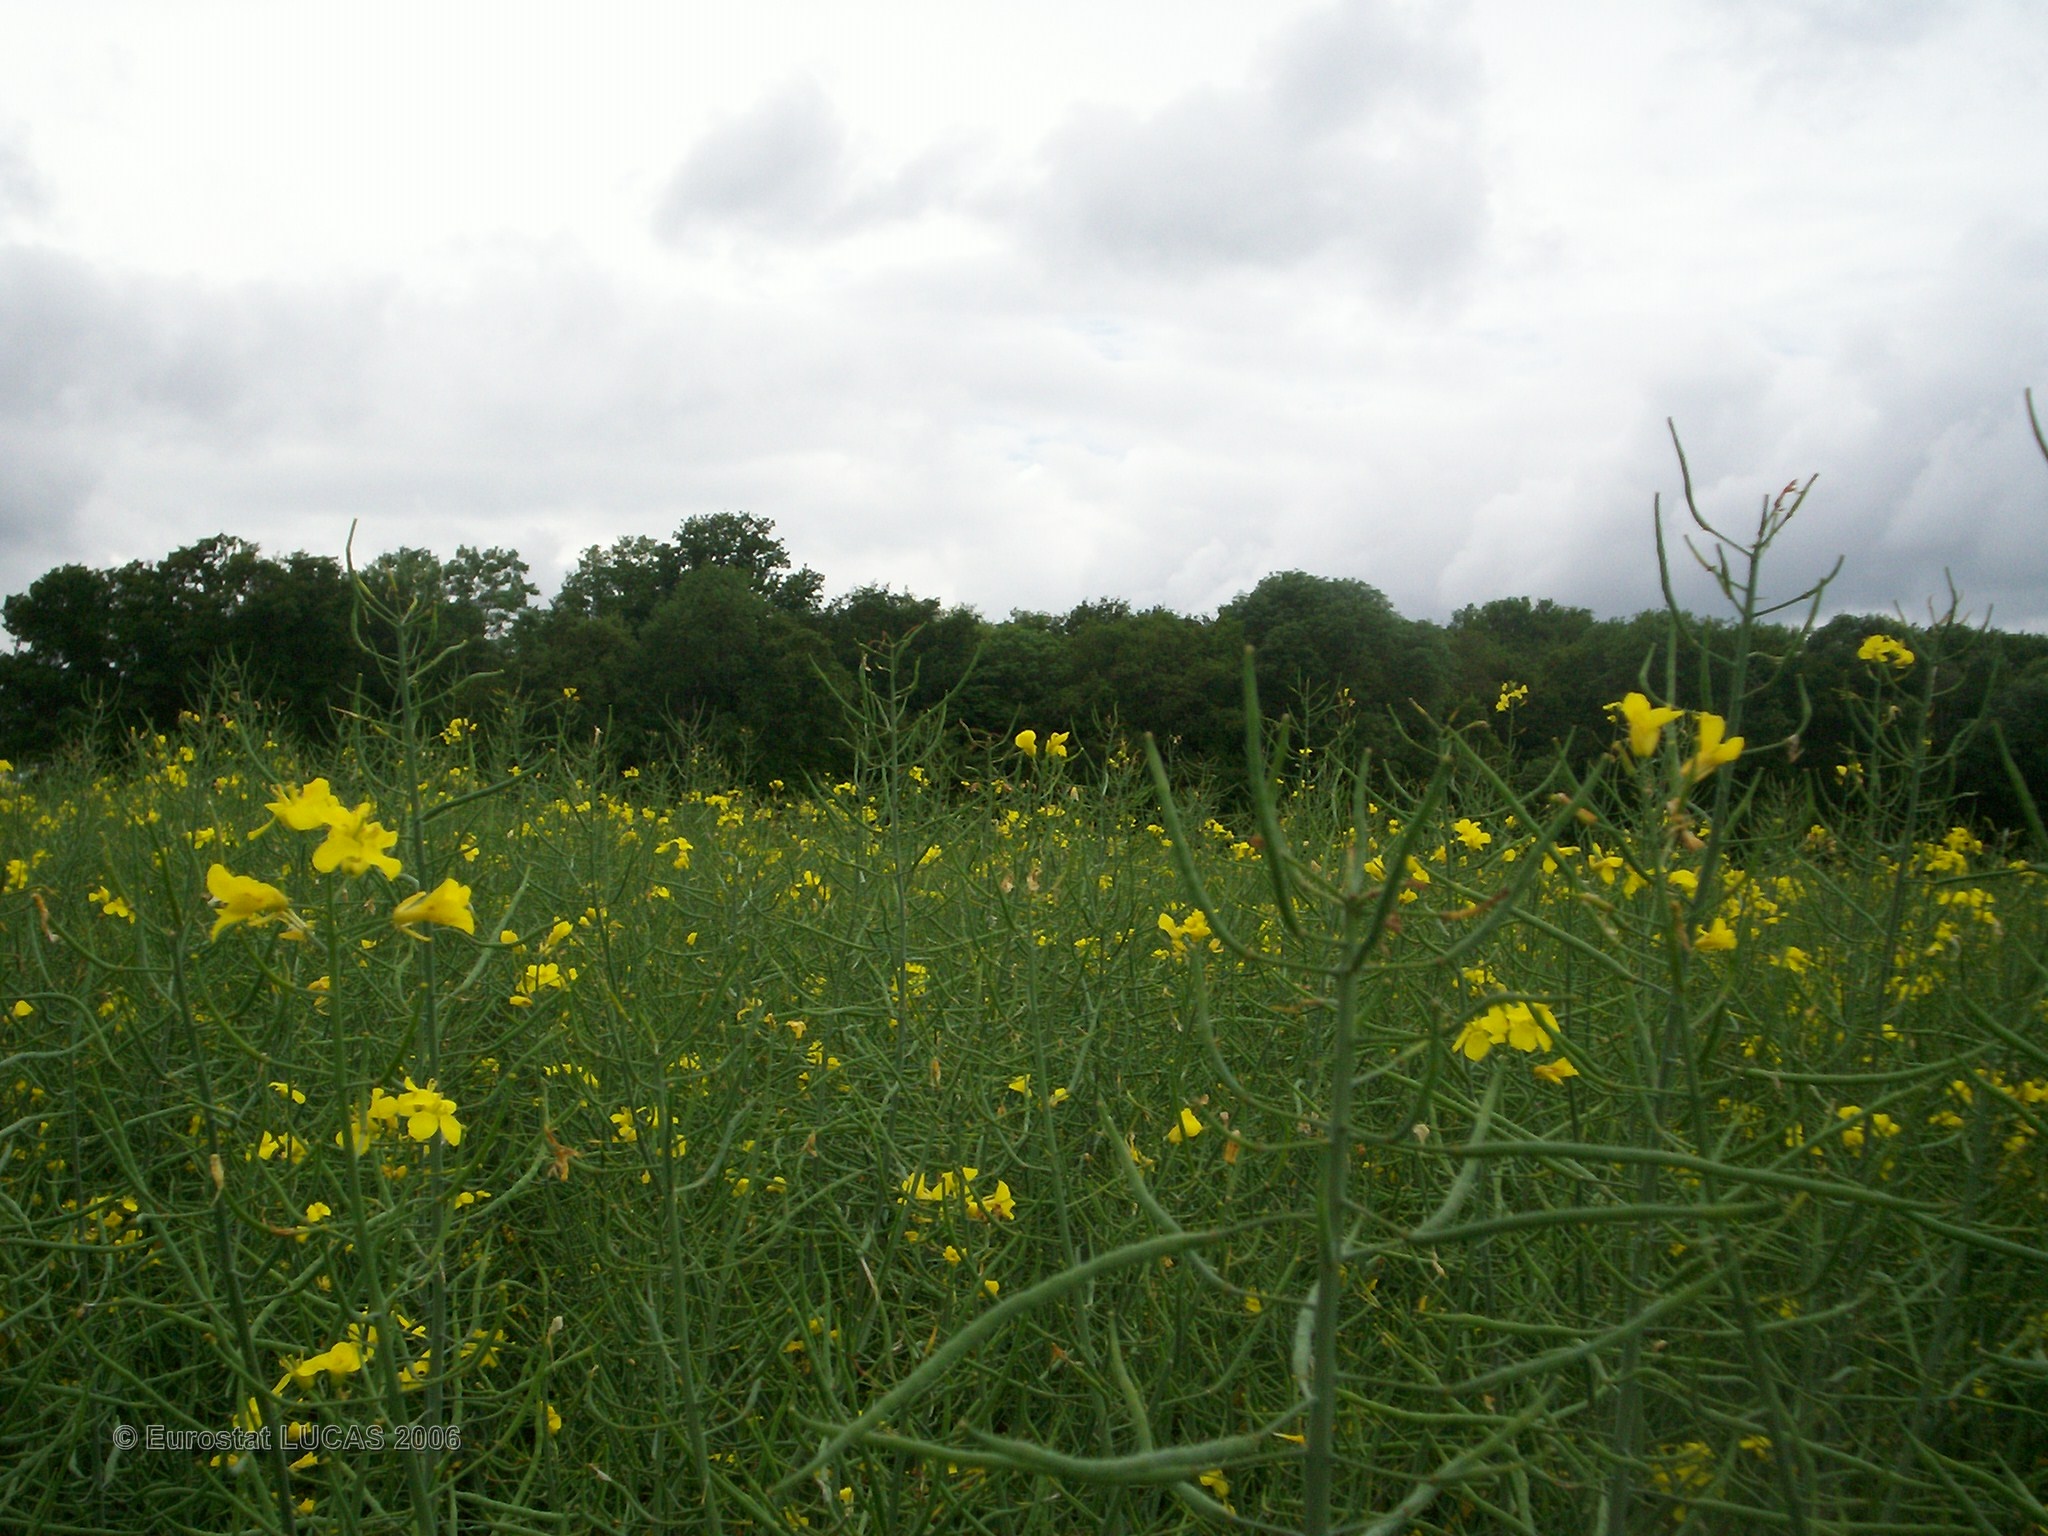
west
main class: Cropland
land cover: Rape and turnip rape
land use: Agriculture (excluding fallow land and kitchen gardens)
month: May
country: FR
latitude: 47.7995
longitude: 2.9572
